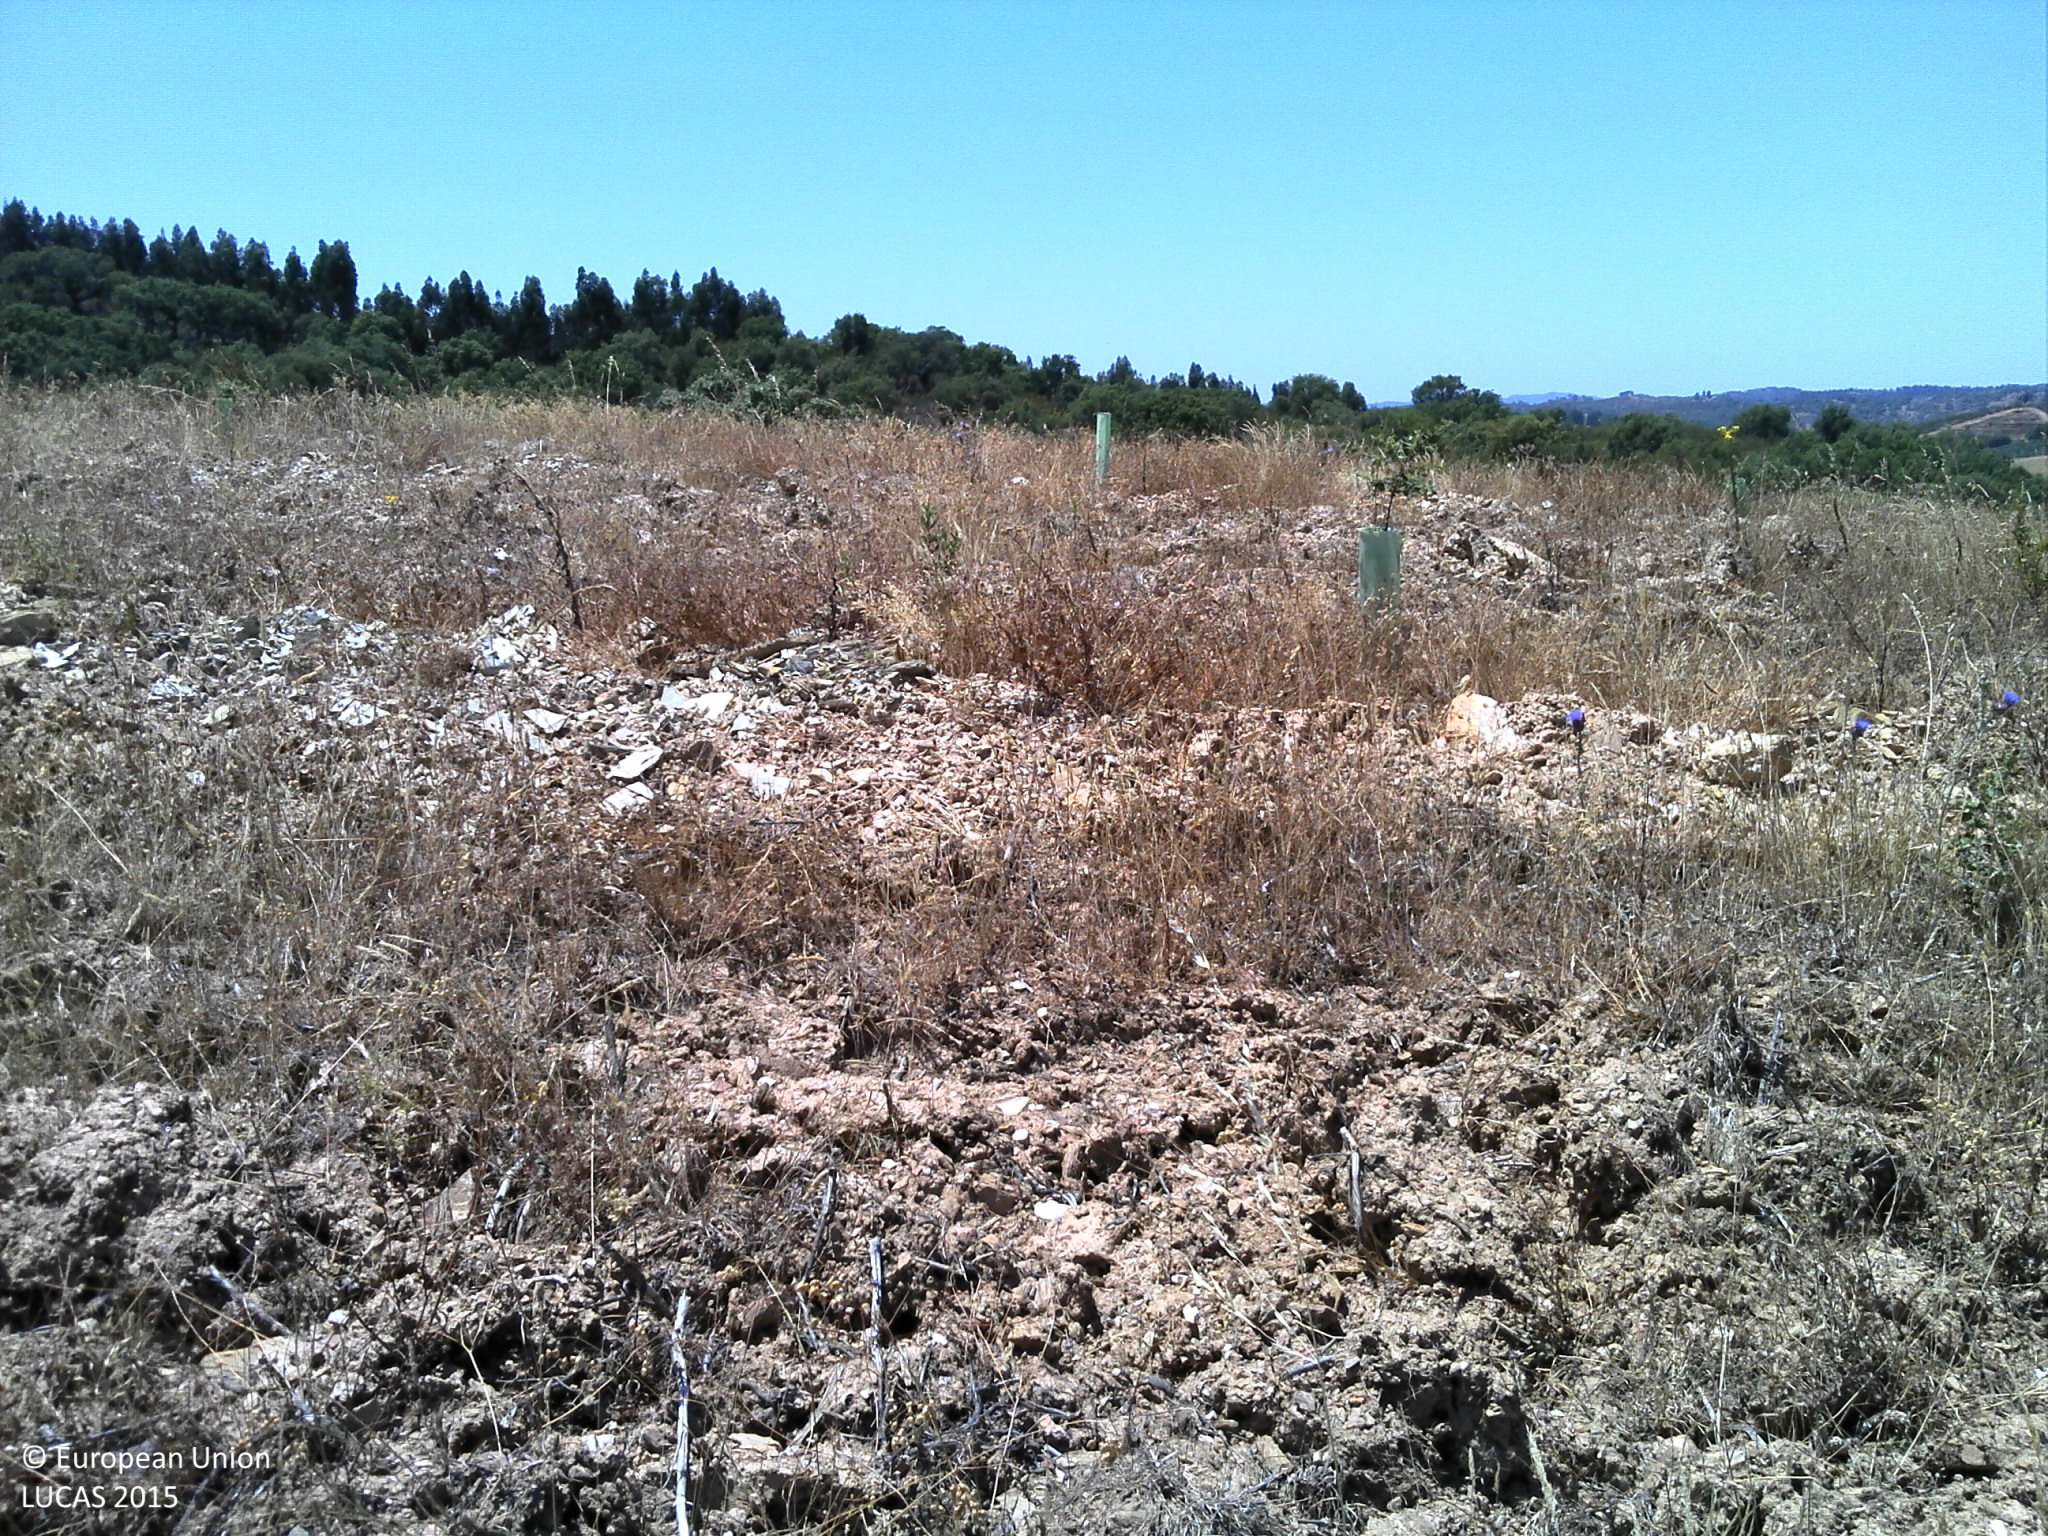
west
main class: Grassland
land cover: Grassland with sparse tree/shrub cover
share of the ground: 25 - 50 %
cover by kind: herbaceous plants 50 %, unconsolidated bare surface 45 %, broadleaved forest trees 5 %
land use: Forestry
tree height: < 5 m
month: June
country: PT
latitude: 37.7141
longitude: -8.4936
